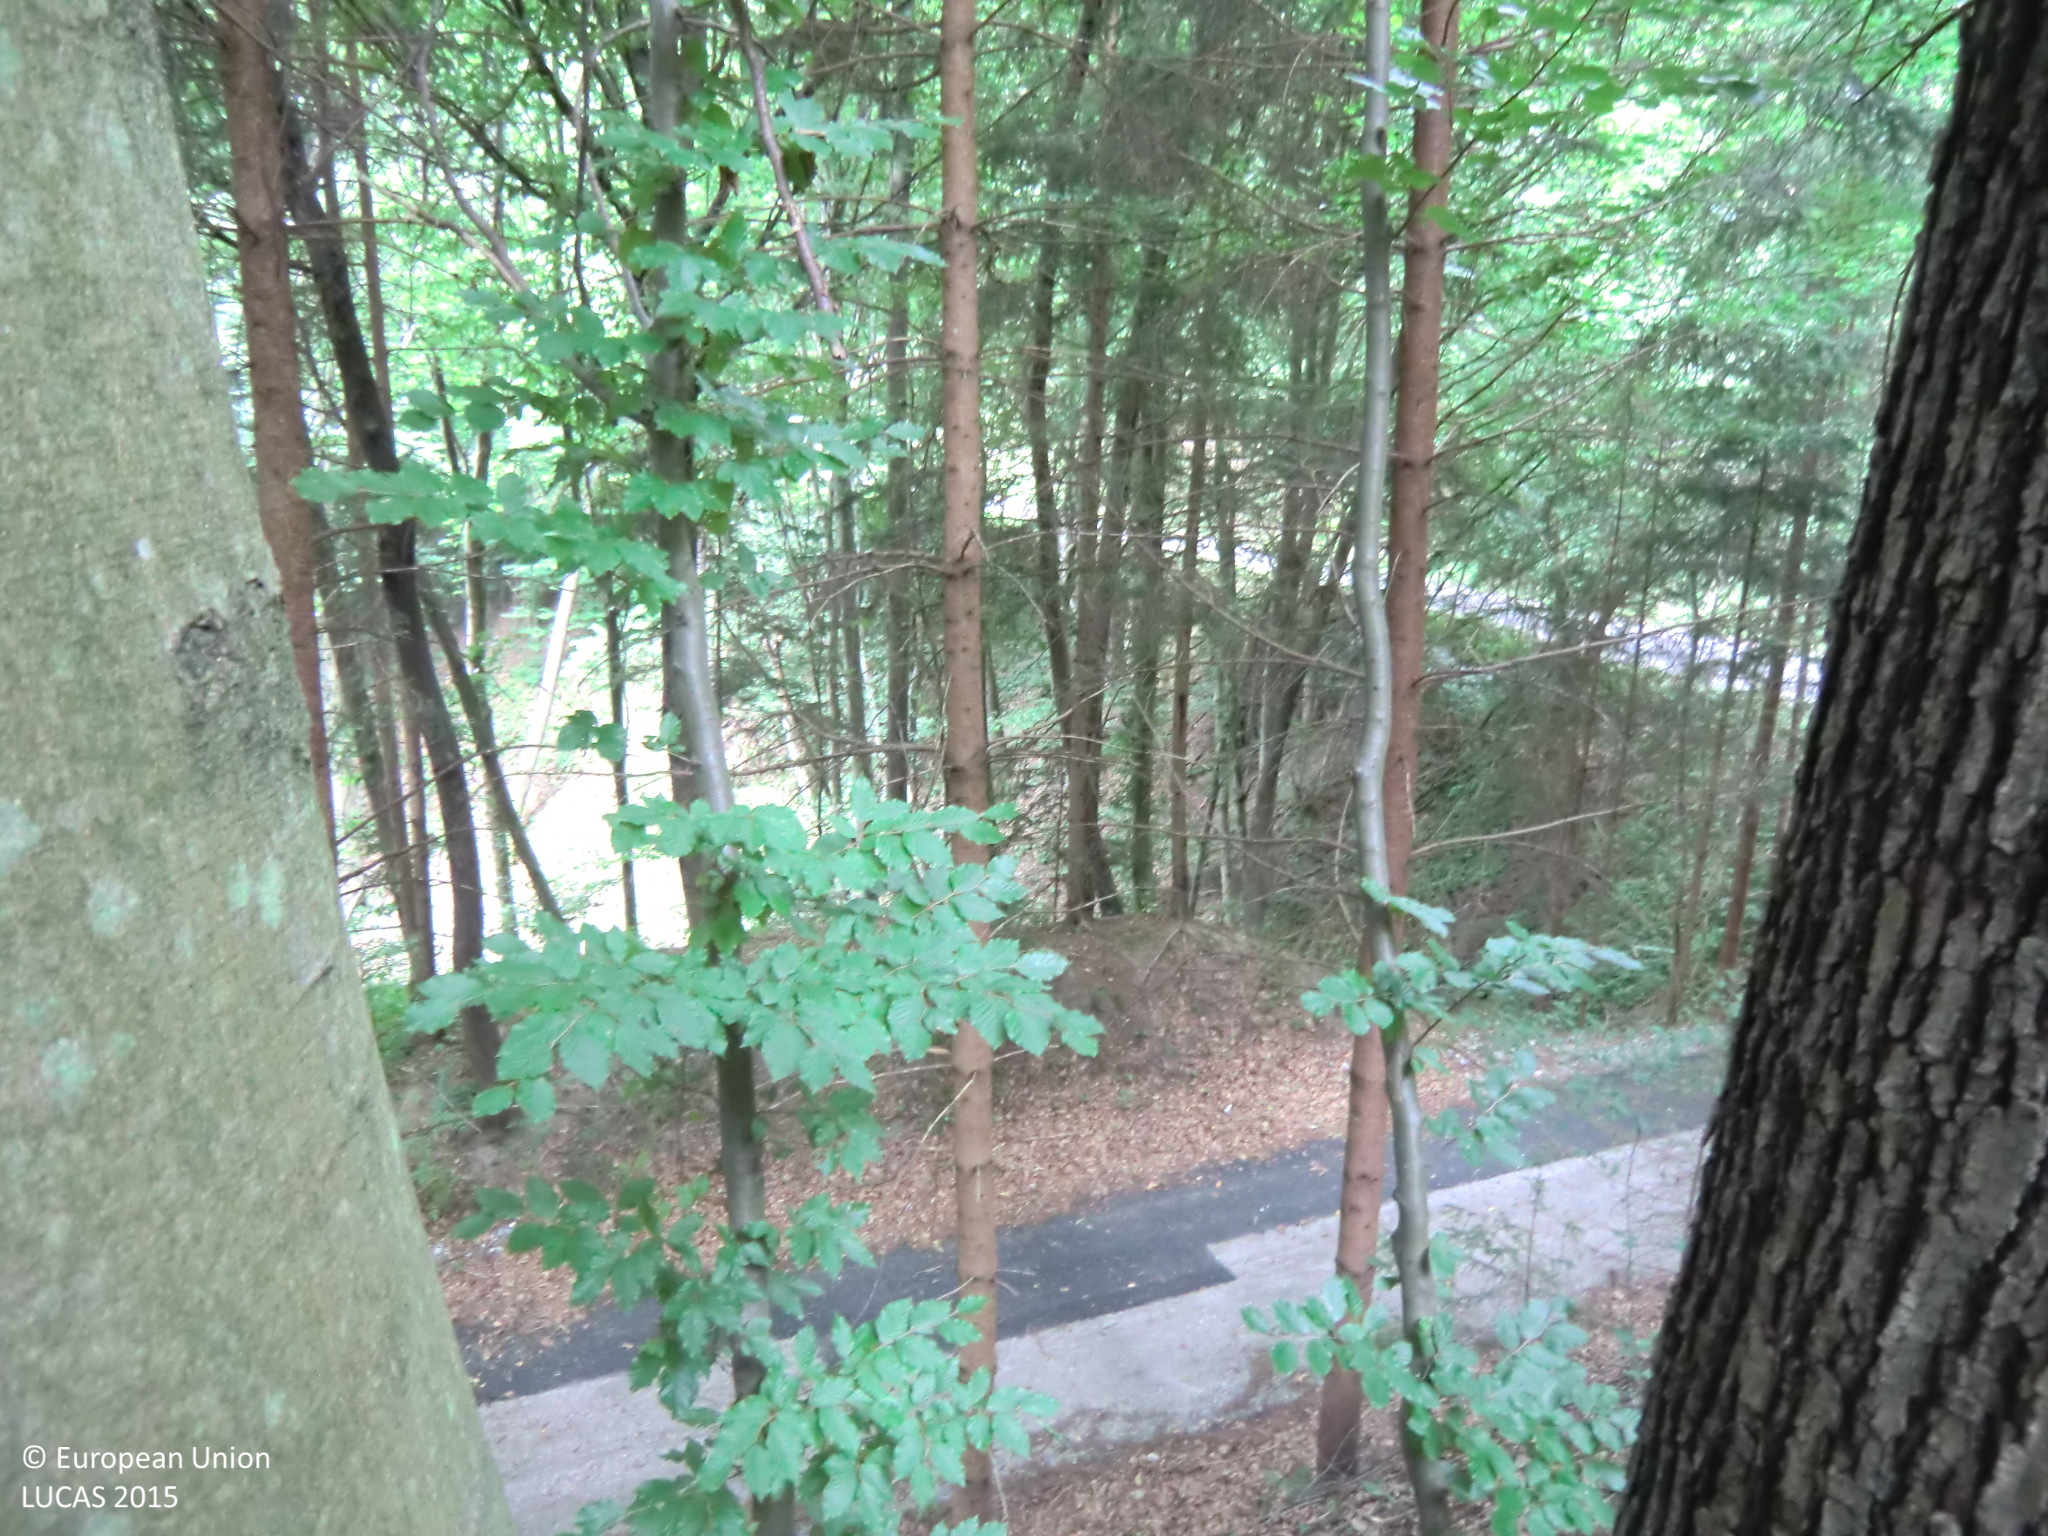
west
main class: Grassland
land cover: Grassland without tree/shrub cover
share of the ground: > 75 %
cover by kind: herbaceous plants 100 %
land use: Residential
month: July
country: AT
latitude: 47.1330
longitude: 15.4449
